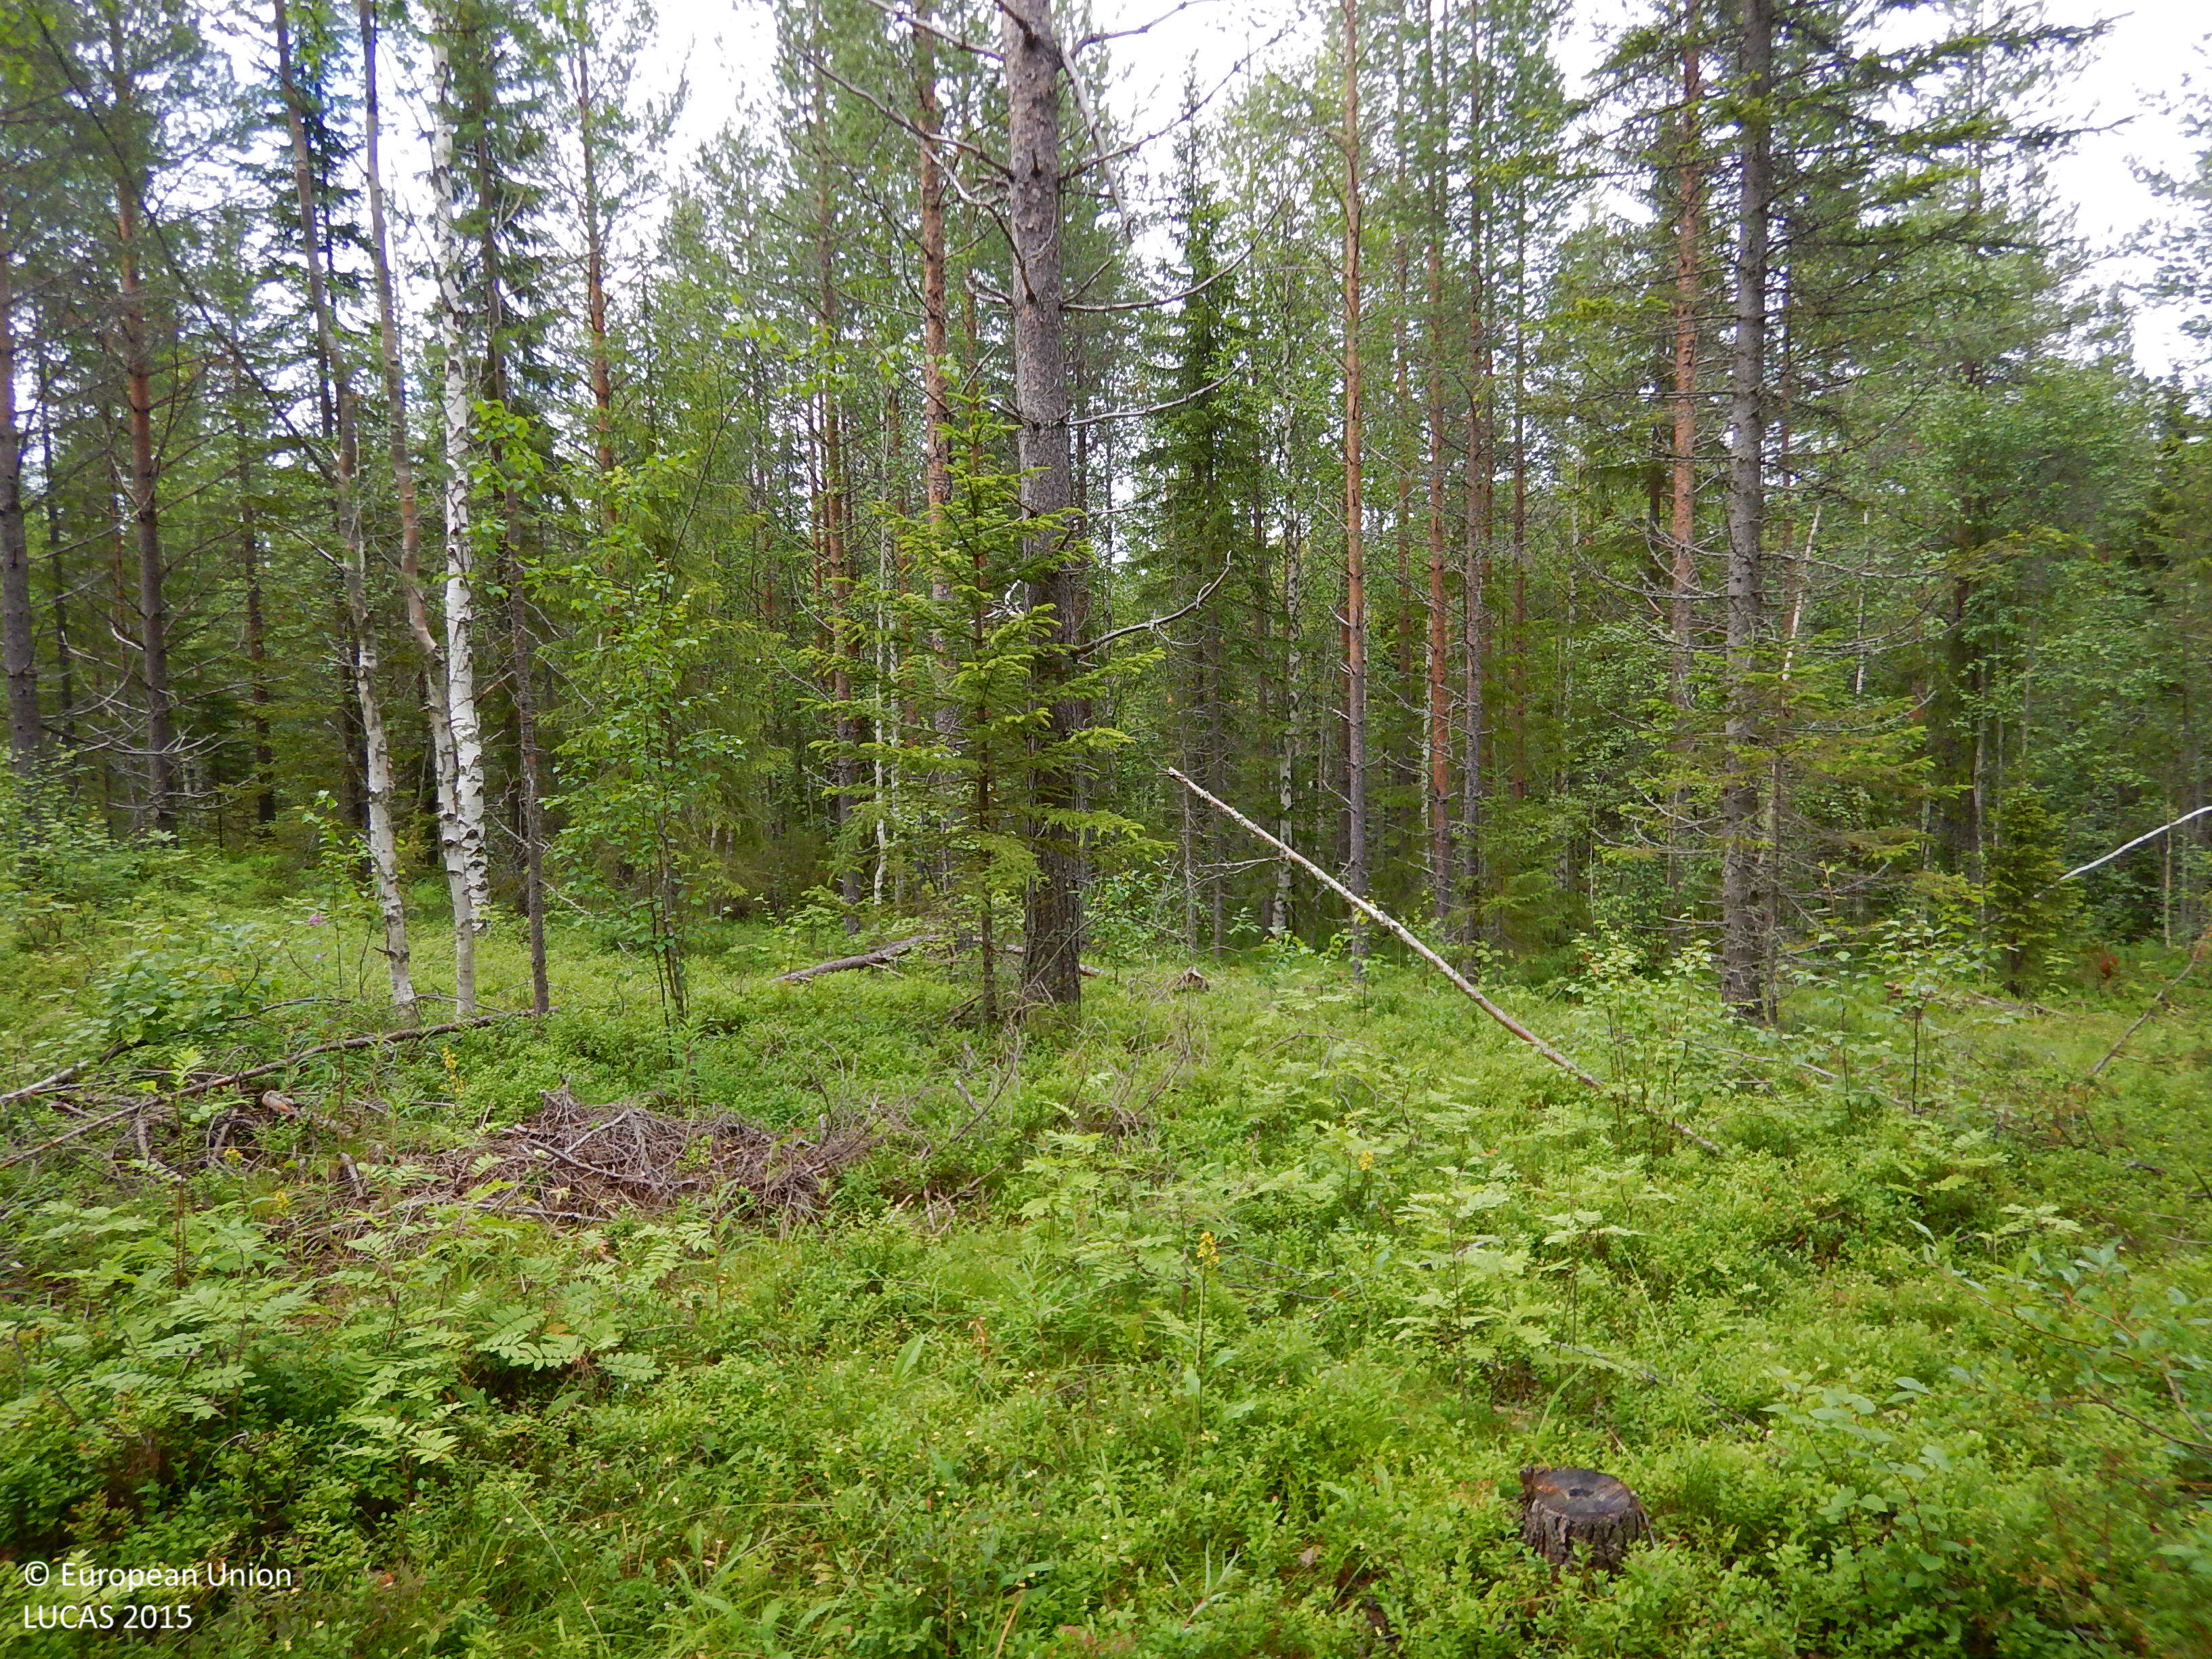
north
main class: Woodland
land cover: Pine dominated mixed woodland
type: boreal forest
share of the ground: 25 - 50 %
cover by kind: shrubs 35 %, coniferous forest trees 30 %, herbaceous plants 15 %, broadleaved forest trees 10 %, lichens and mosses 10 %
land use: Forestry
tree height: > 5 m
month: July
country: SE
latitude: 64.9113
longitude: 20.4353
